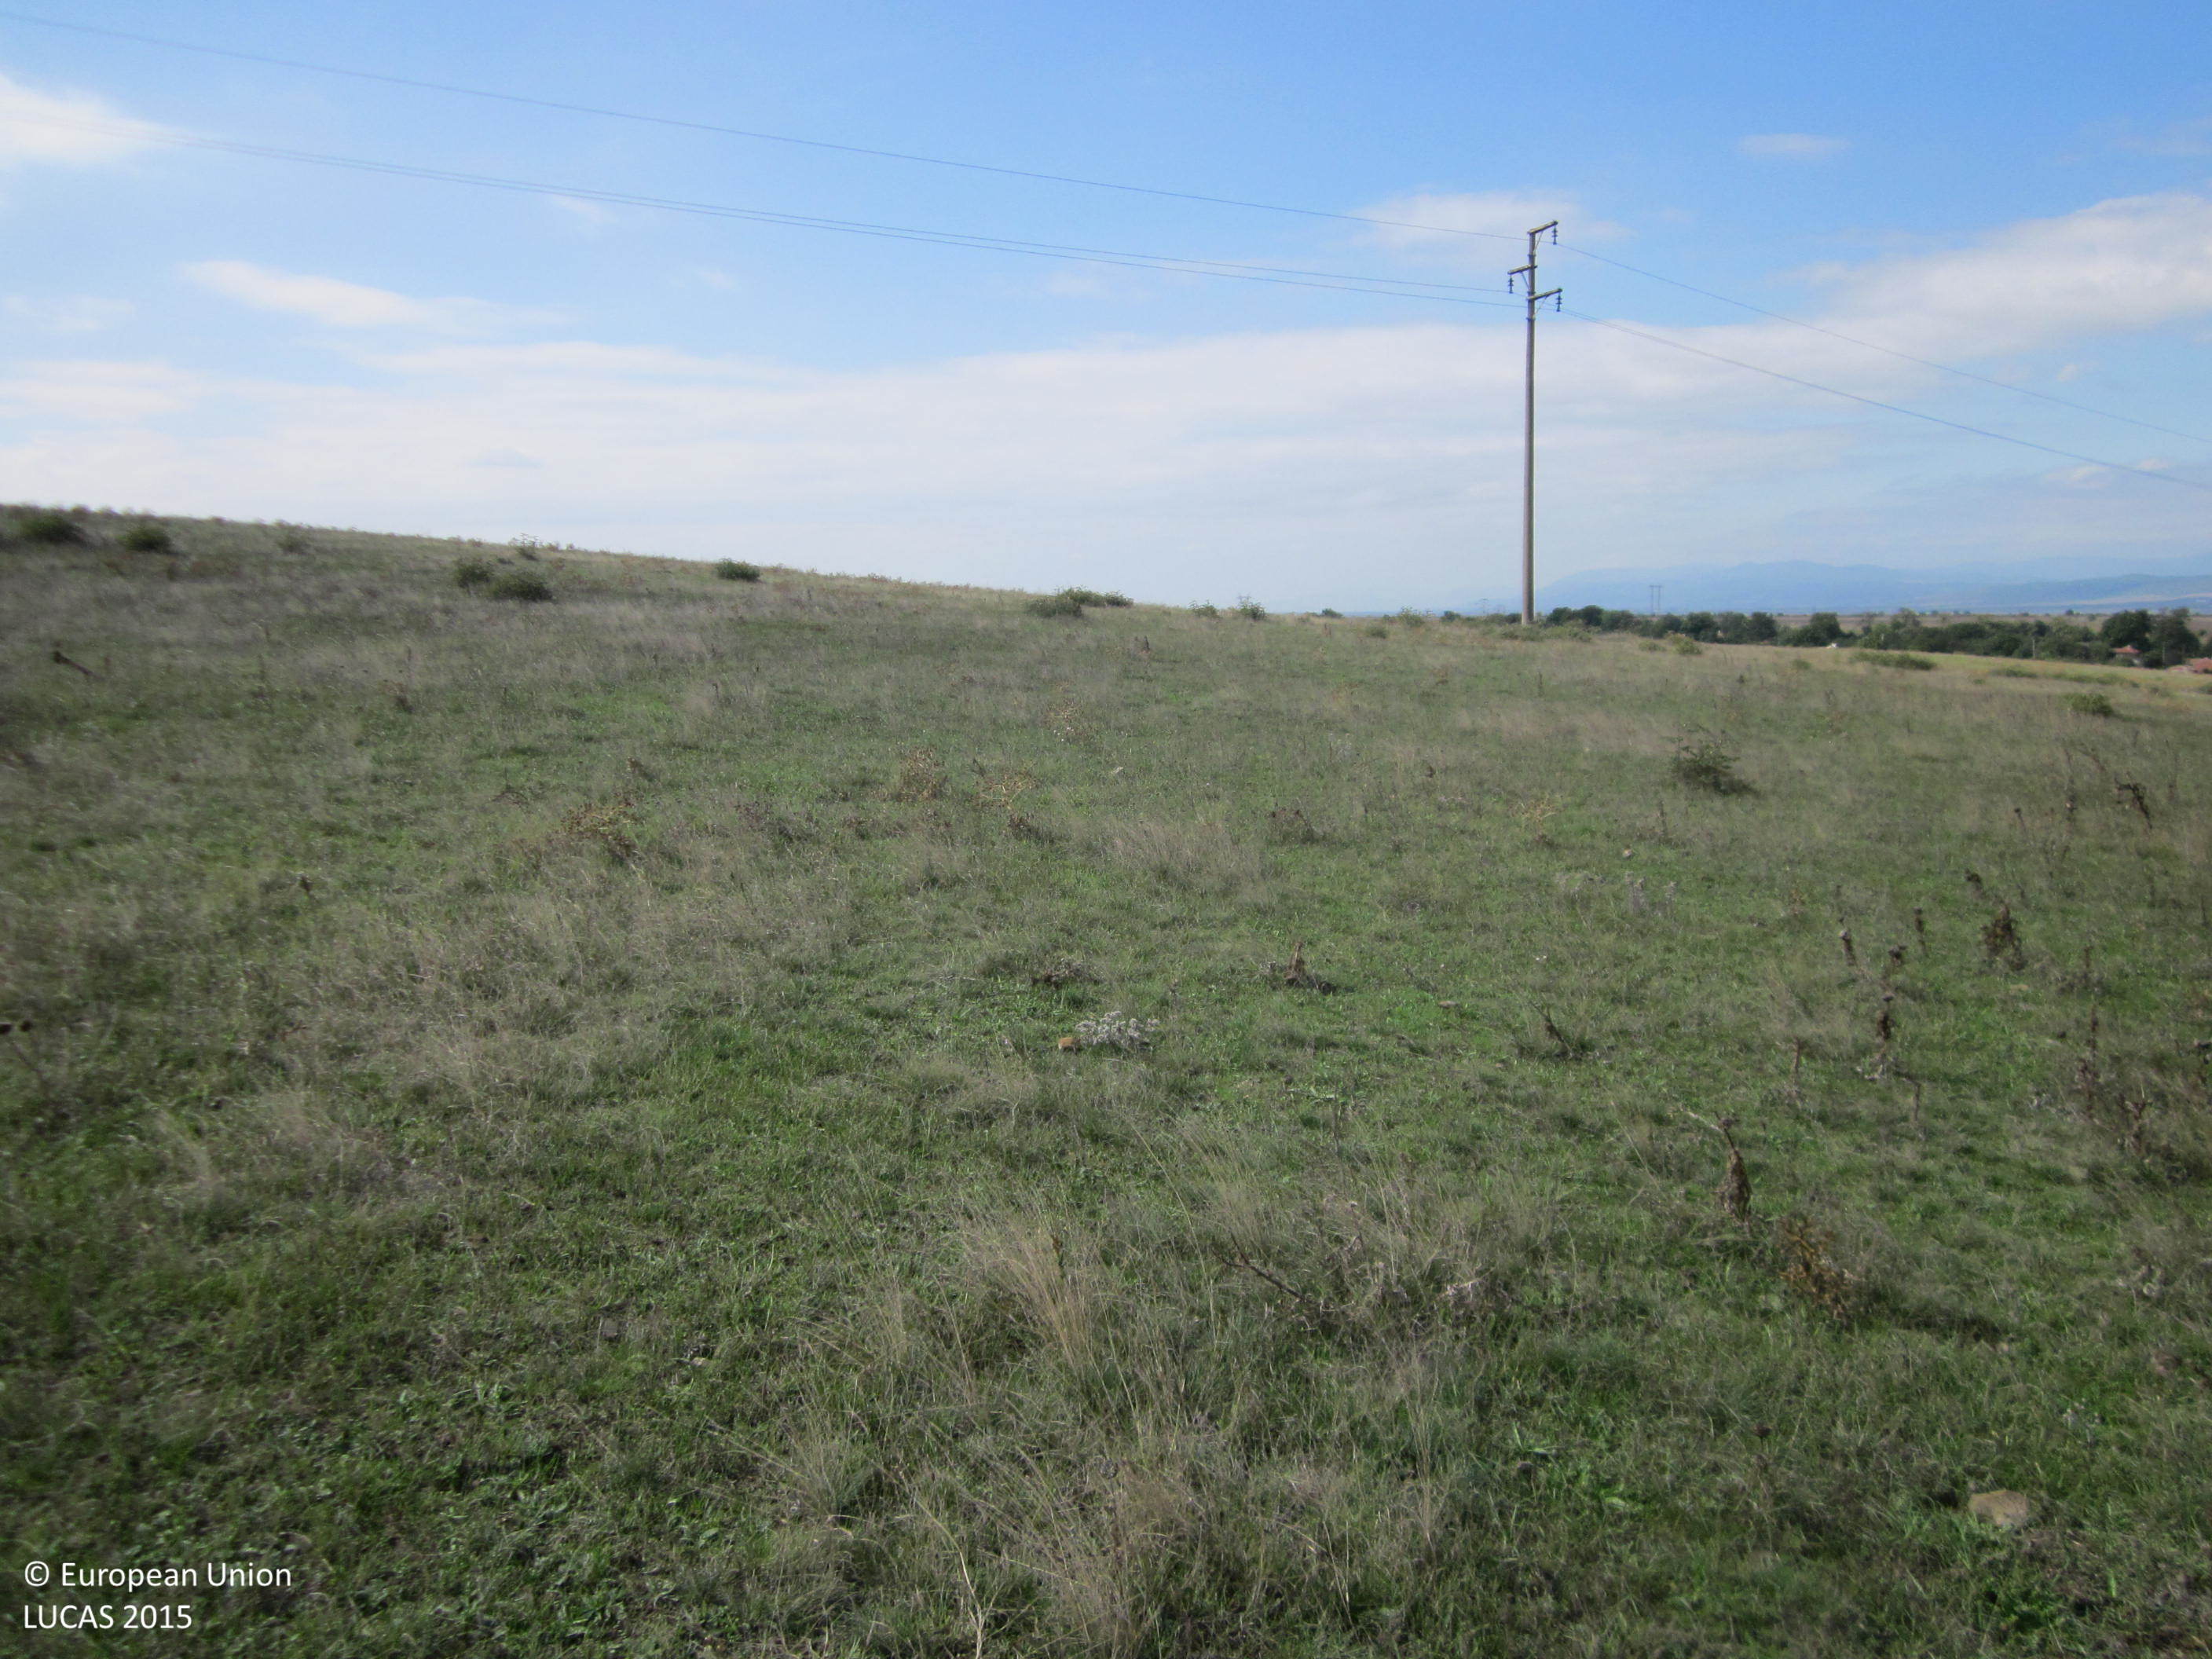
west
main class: Grassland
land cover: Grassland without tree/shrub cover
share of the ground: > 75 %
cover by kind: herbaceous plants 100 %
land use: Agriculture (excluding fallow land and kitchen gardens)
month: October
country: BG
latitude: 42.5951
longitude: 26.8345
